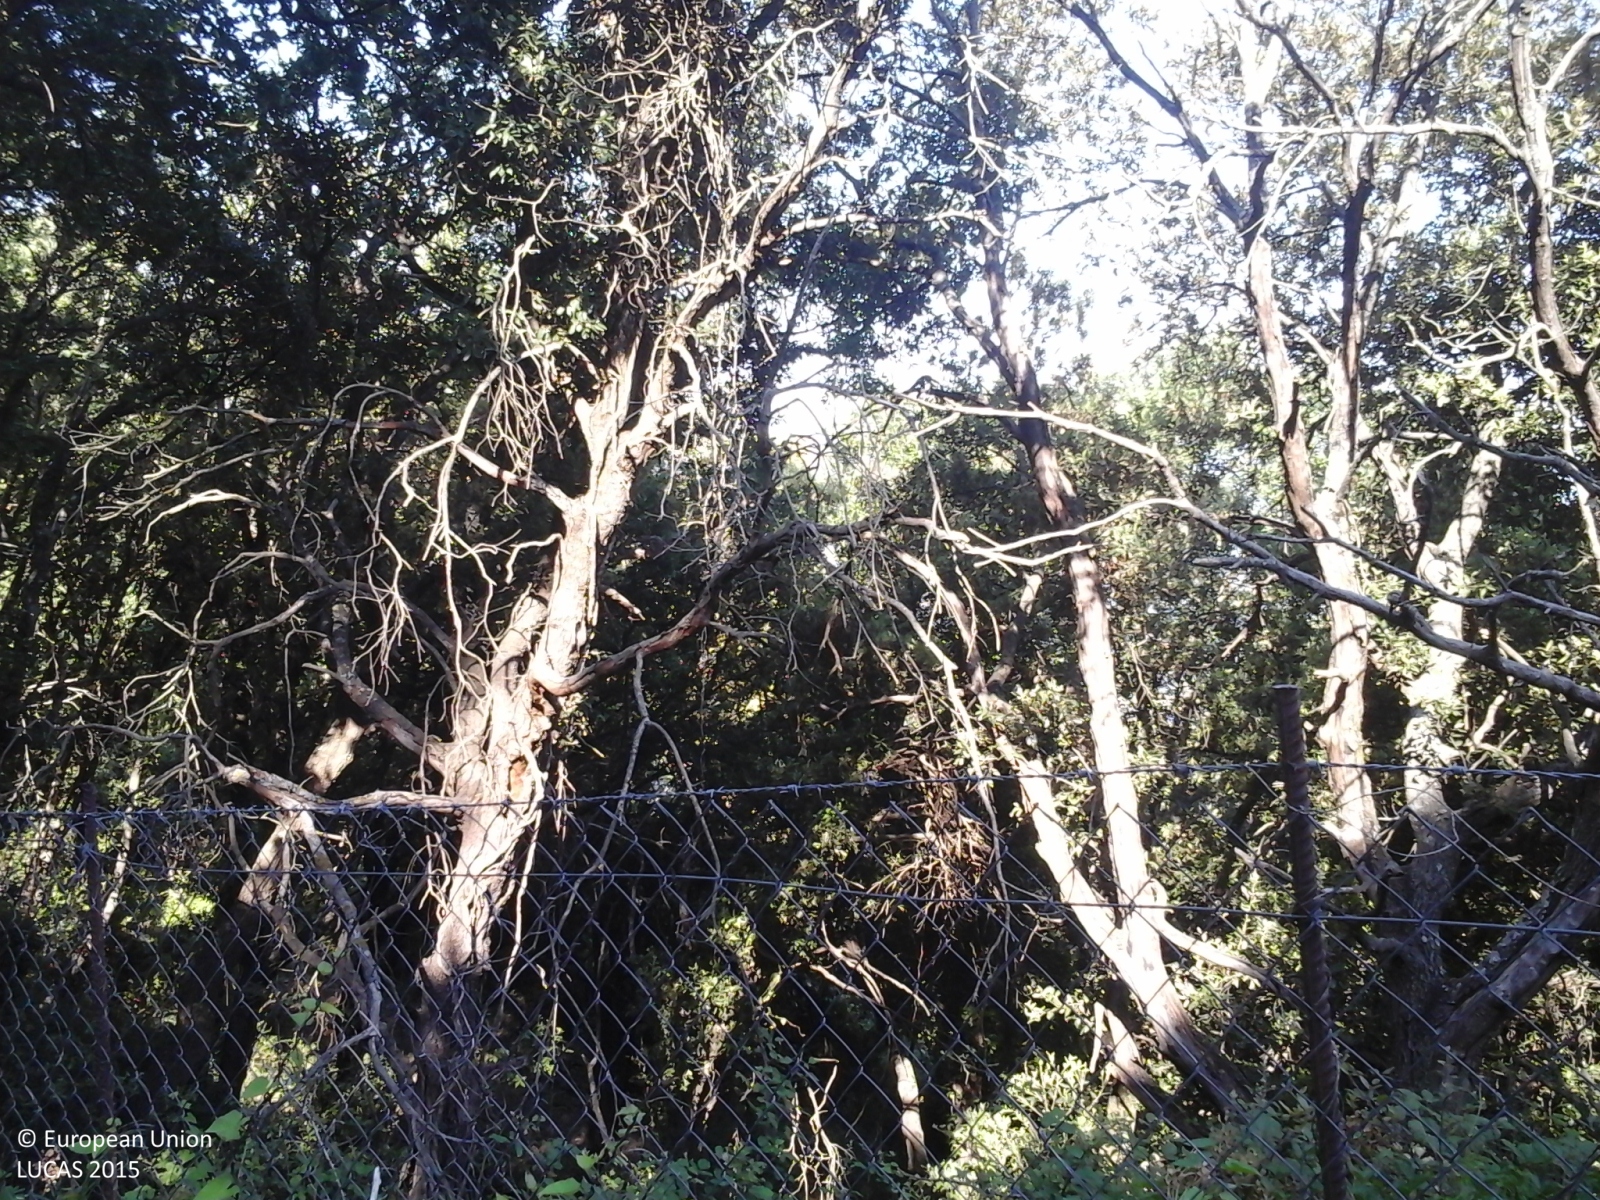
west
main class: Woodland
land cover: Broadleaved woodland
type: broadleaved evergreen forest
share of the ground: > 75 %
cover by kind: broadleaved forest trees 85 %, shrubs 10 %, herbaceous plants 5 %
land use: Forestry
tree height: > 5 m
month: June
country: IT
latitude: 37.9898
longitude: 14.0142
